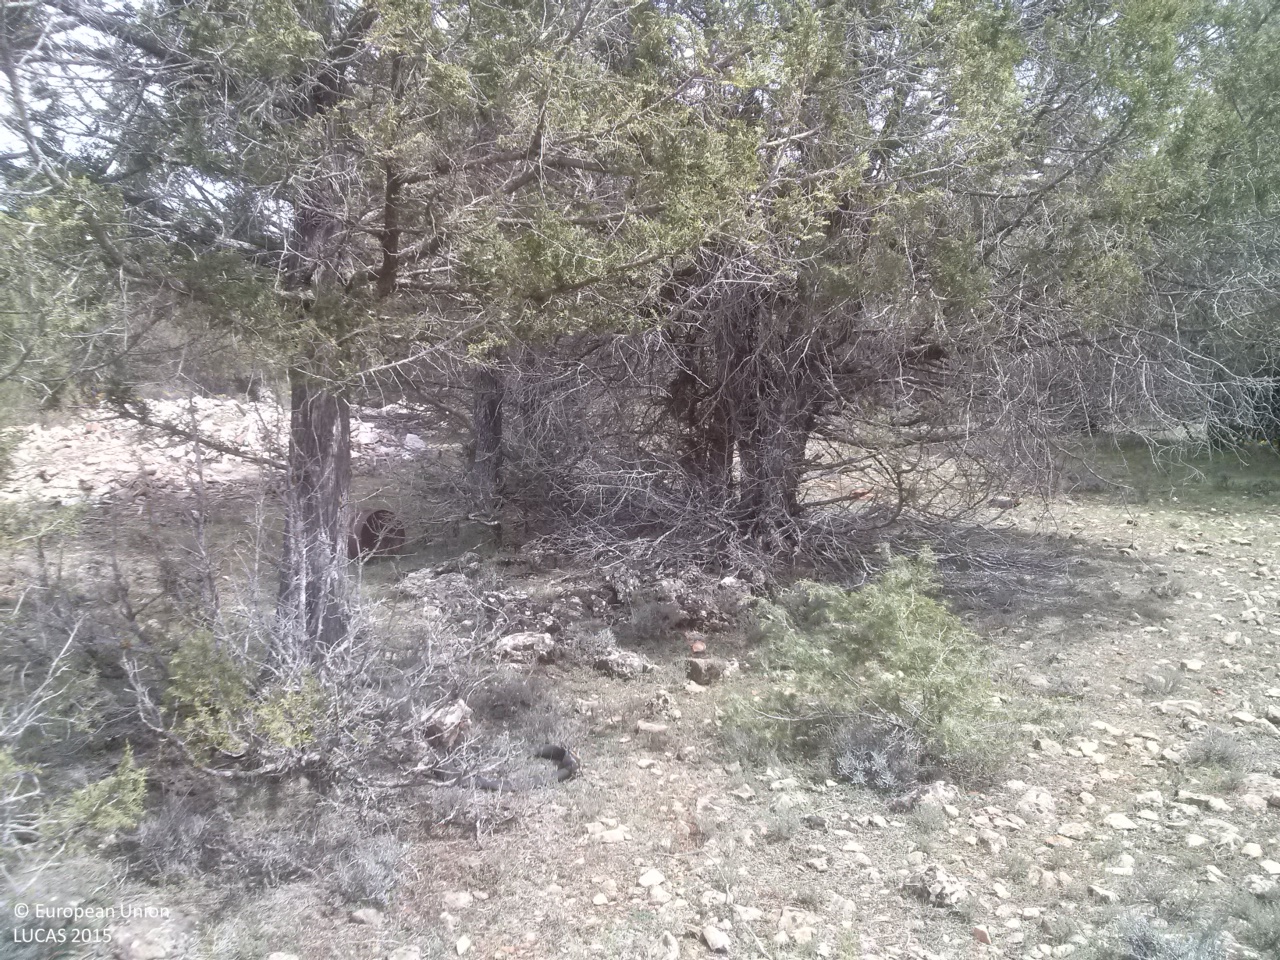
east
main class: Woodland
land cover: Other coniferous woodland
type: coniferous forest of the mediterranean region
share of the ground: 10 - 25 %
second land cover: Grassland without tree/shrub cover
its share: 50 - 75 %
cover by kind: herbaceous plants 60 %, coniferous forest trees 20 %, unconsolidated bare surface 15 %, shrubs 5 %
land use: Forestry
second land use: Agriculture (excluding fallow land and kitchen gardens)
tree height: > 5 m
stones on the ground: > 50 %
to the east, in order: Other coniferous woodland; Grassland without tree/shrub cover; Other coniferous woodland; Tracks; Other coniferous woodland
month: April
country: ES
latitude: 40.0410
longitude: -1.8386
